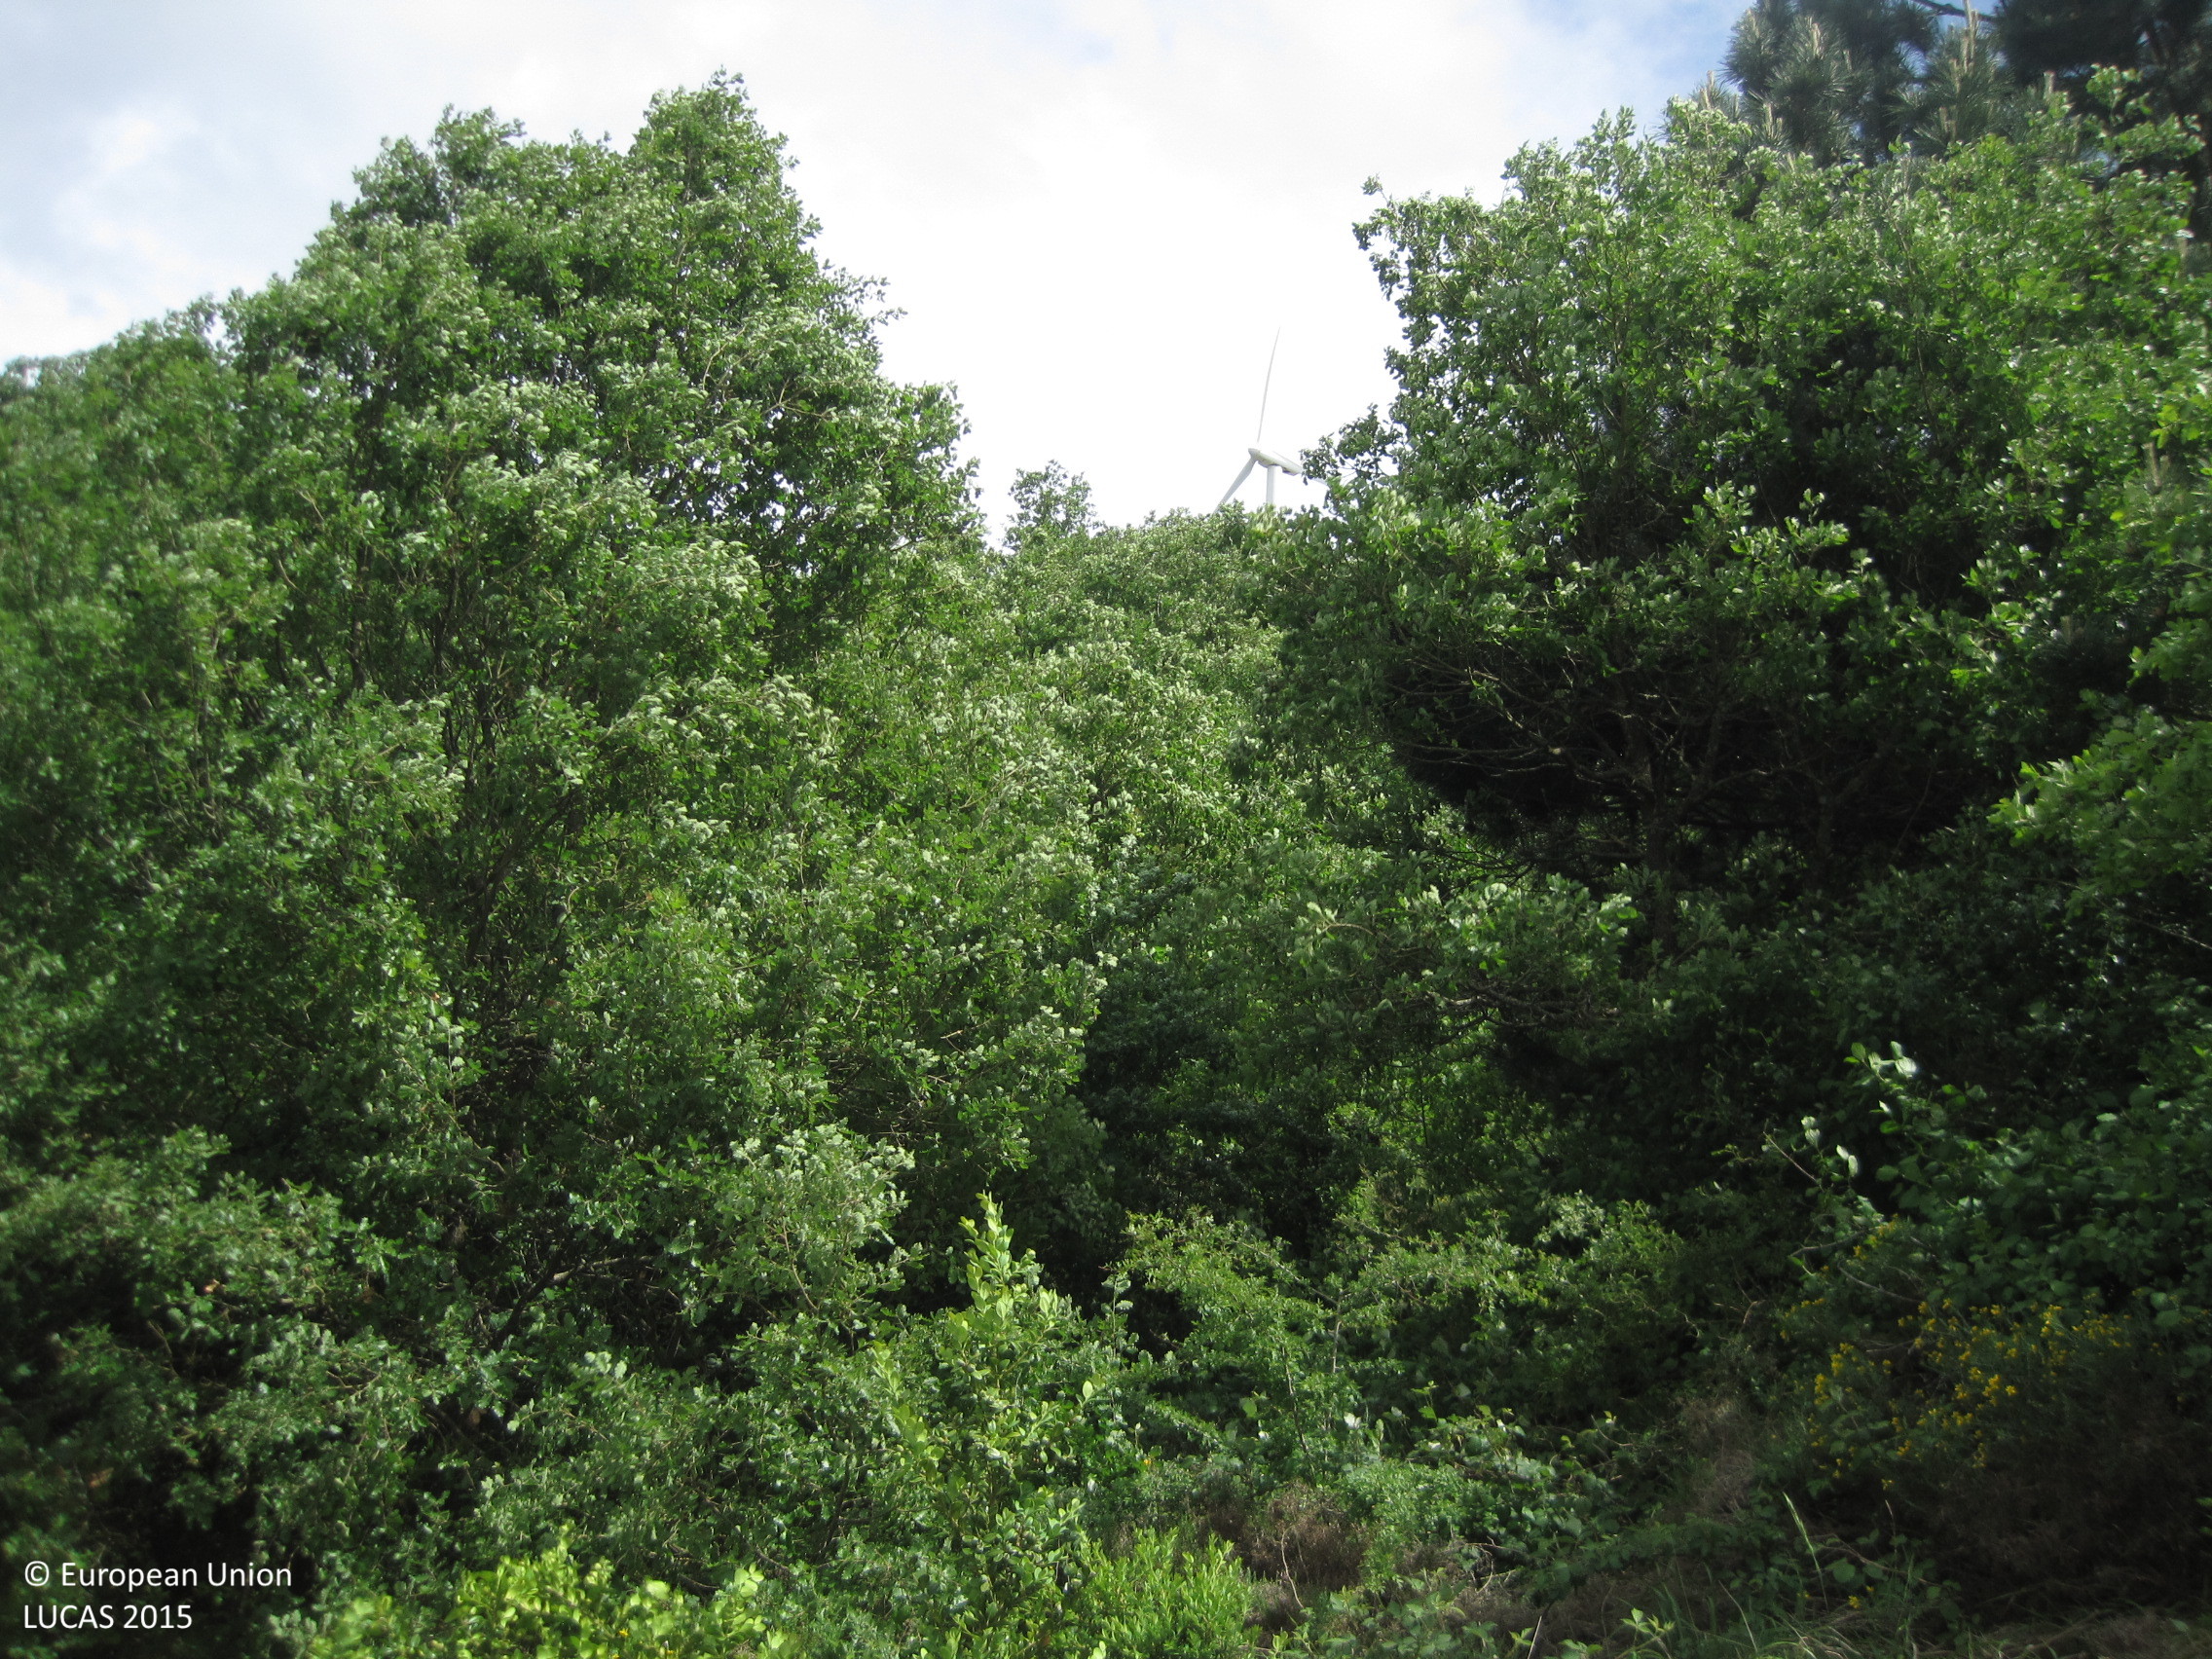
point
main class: Woodland
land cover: Broadleaved woodland
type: acidophilous oak and oak-birch forest
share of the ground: > 75 %
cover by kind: broadleaved forest trees 100 %
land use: Semi-natural and natural areas not in use
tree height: > 5 m
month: May
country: ES
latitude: 42.7357
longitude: -1.7285
